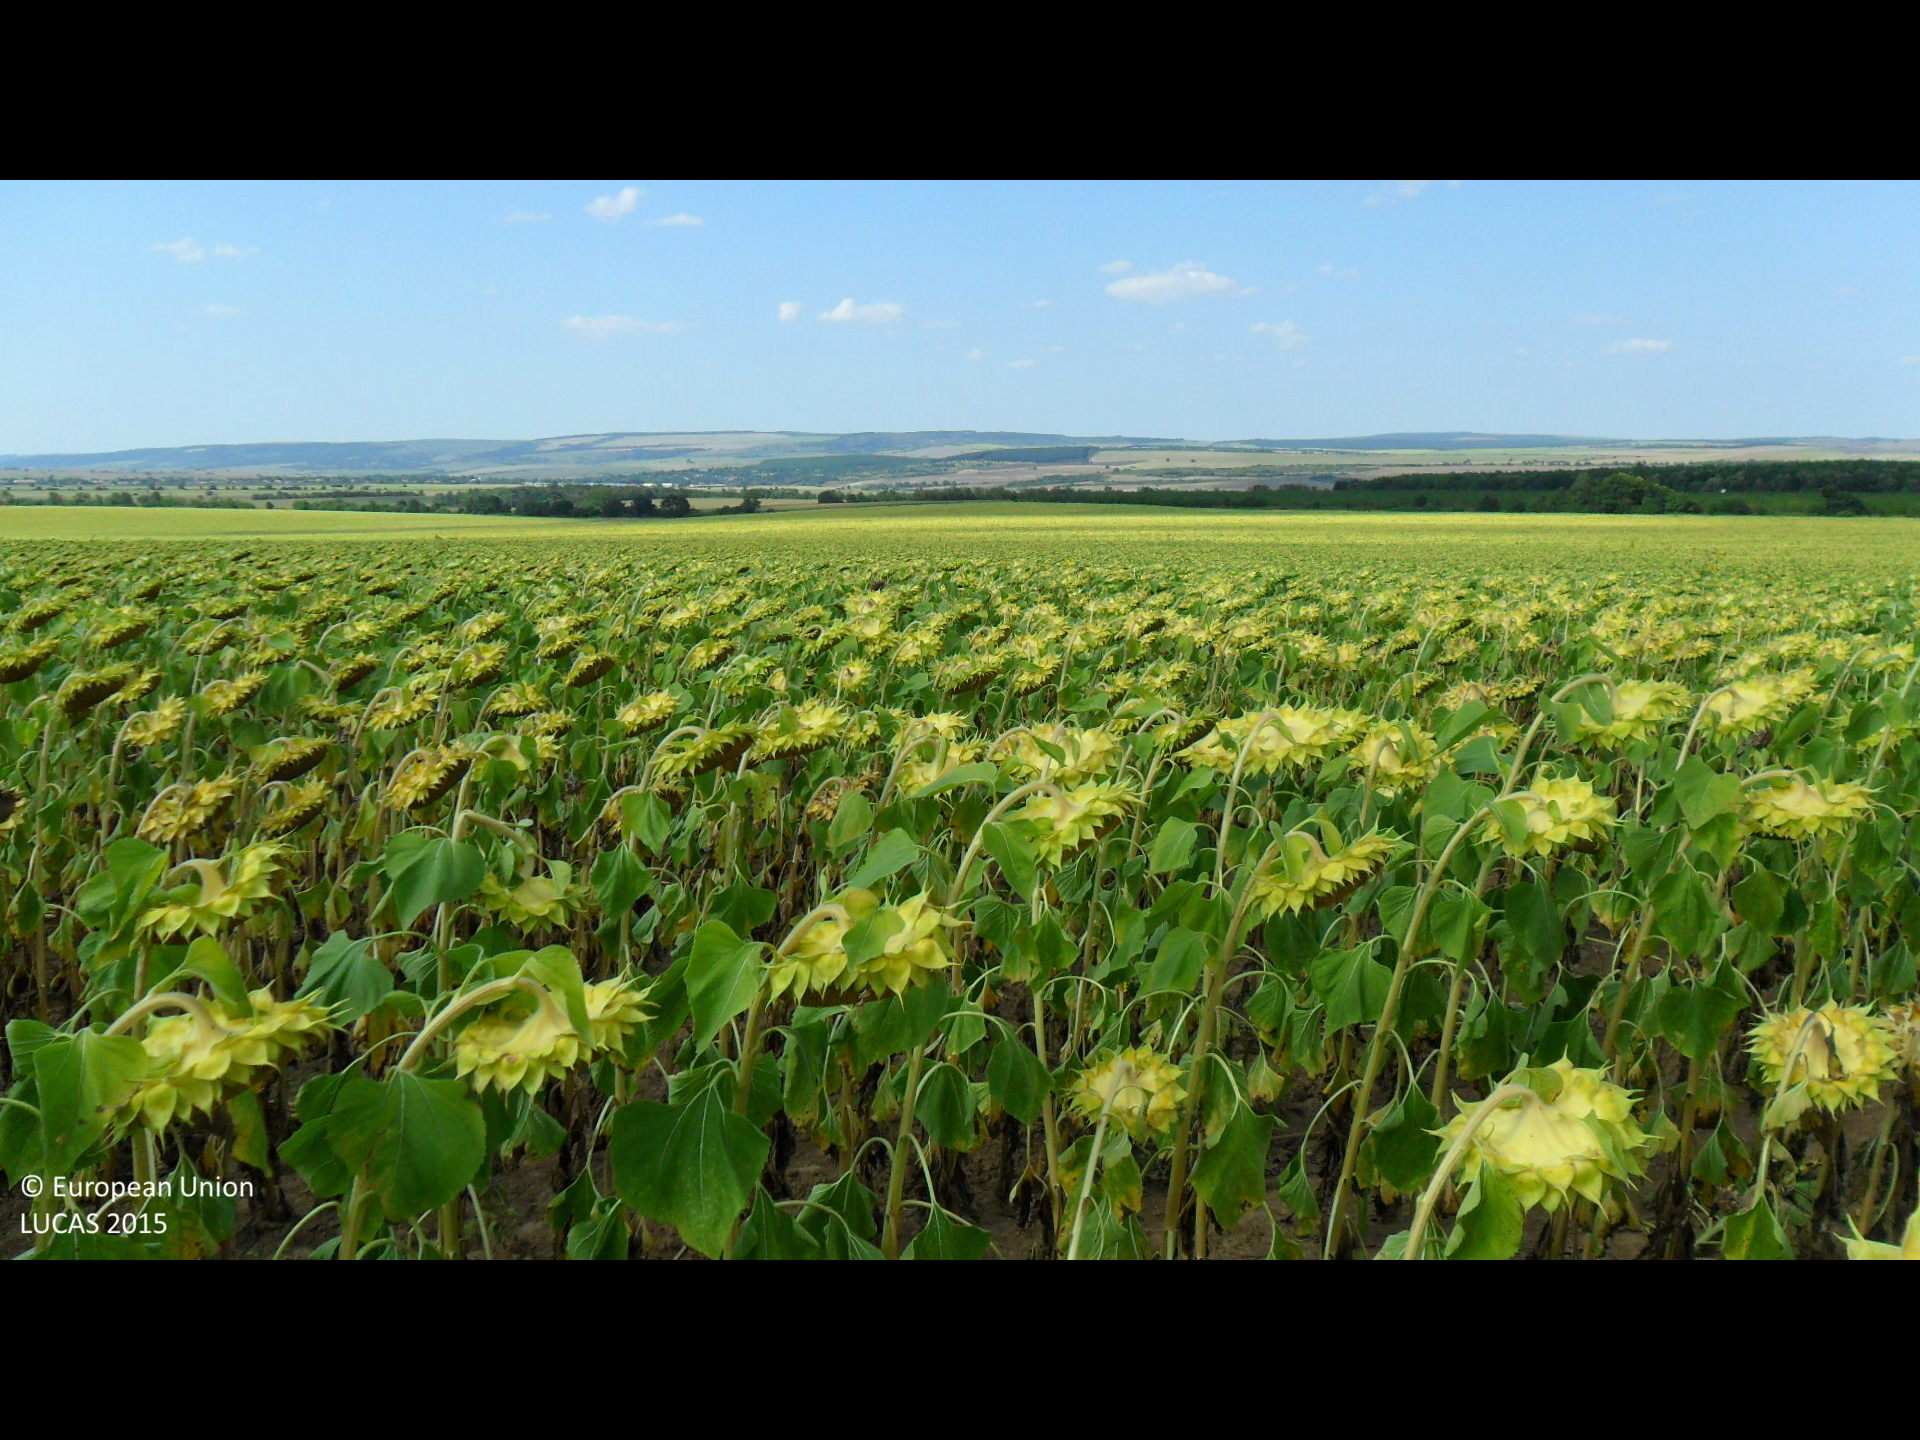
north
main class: Cropland
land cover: Sunflower
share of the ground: > 75 %
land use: Agriculture (excluding fallow land and kitchen gardens)
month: August
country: BG
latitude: 43.3908
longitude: 26.3586
